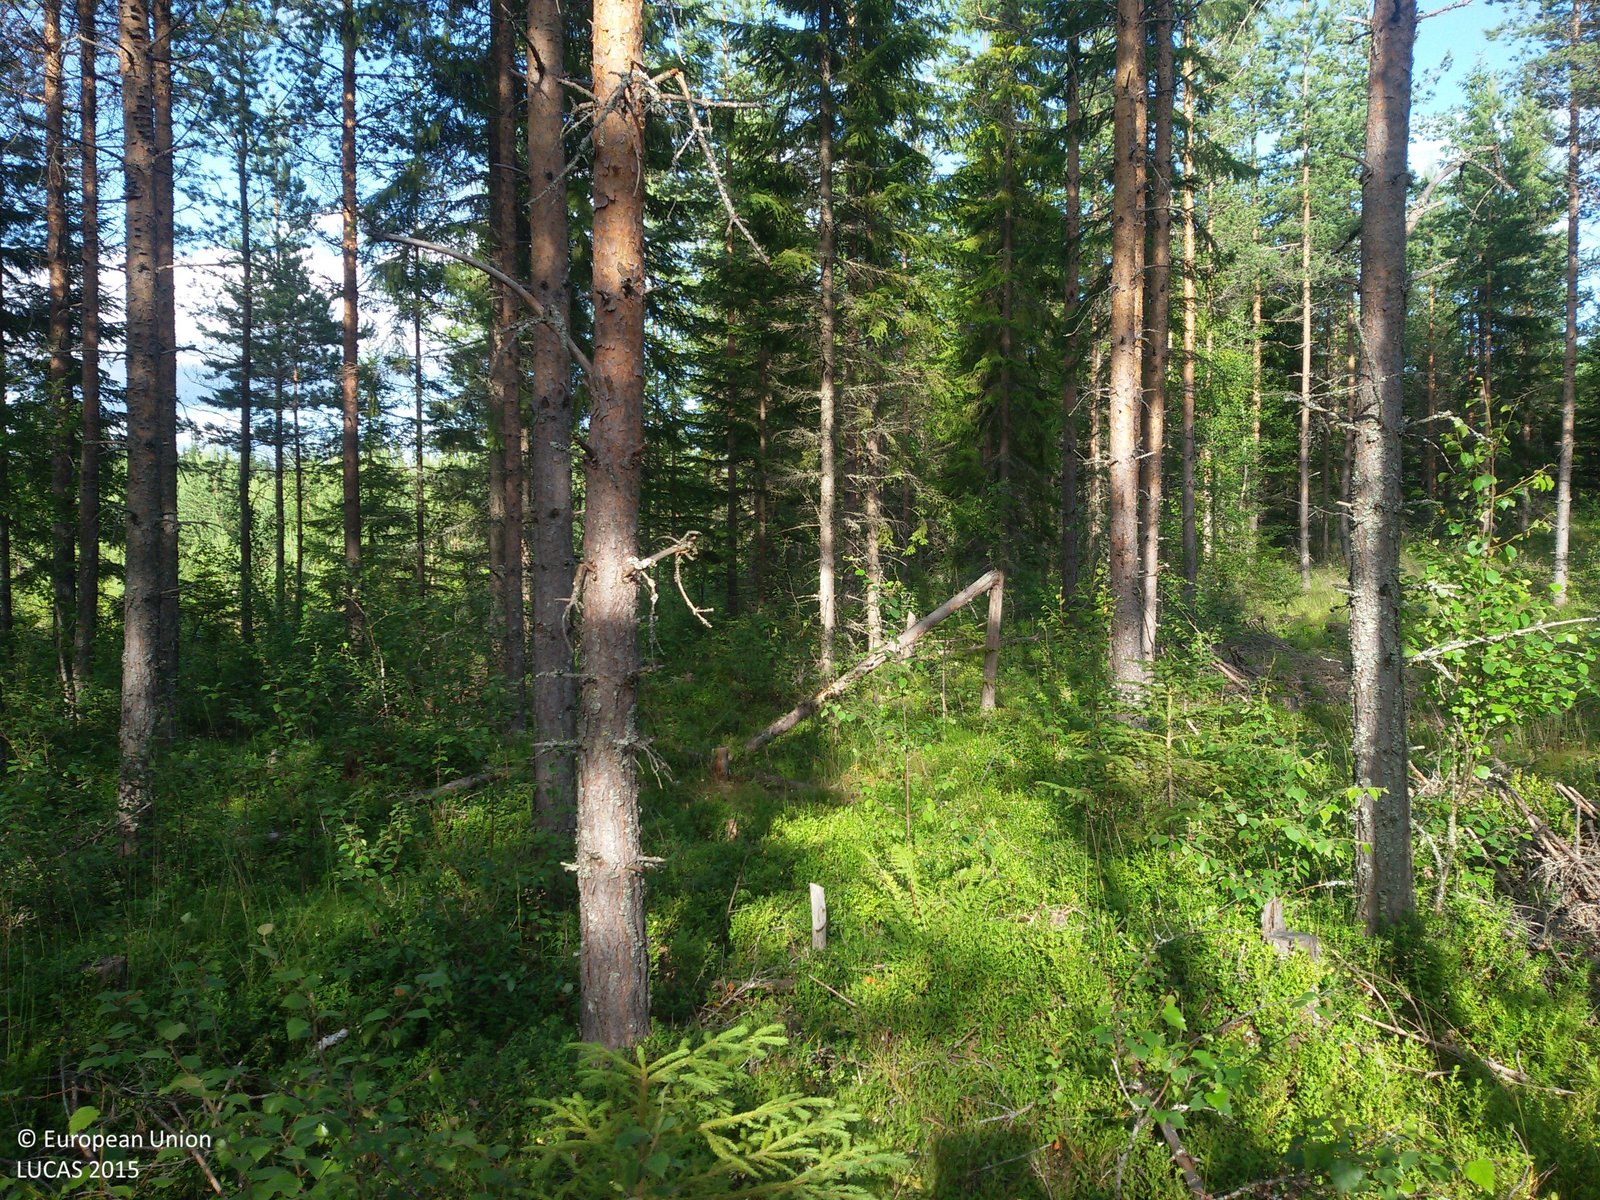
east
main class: Woodland
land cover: Pine dominated coniferous woodland
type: boreal forest
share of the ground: 50 - 75 %
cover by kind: coniferous forest trees 50 %, shrubs 30 %, broadleaved forest trees 10 %, lichens and mosses 10 %
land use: Forestry
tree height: > 5 m
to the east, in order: Pine dominated coniferous woodland; Pine dominated mixed woodland; Pine dominated coniferous woodland
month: July
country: SE
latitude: 60.5147
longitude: 15.2879
